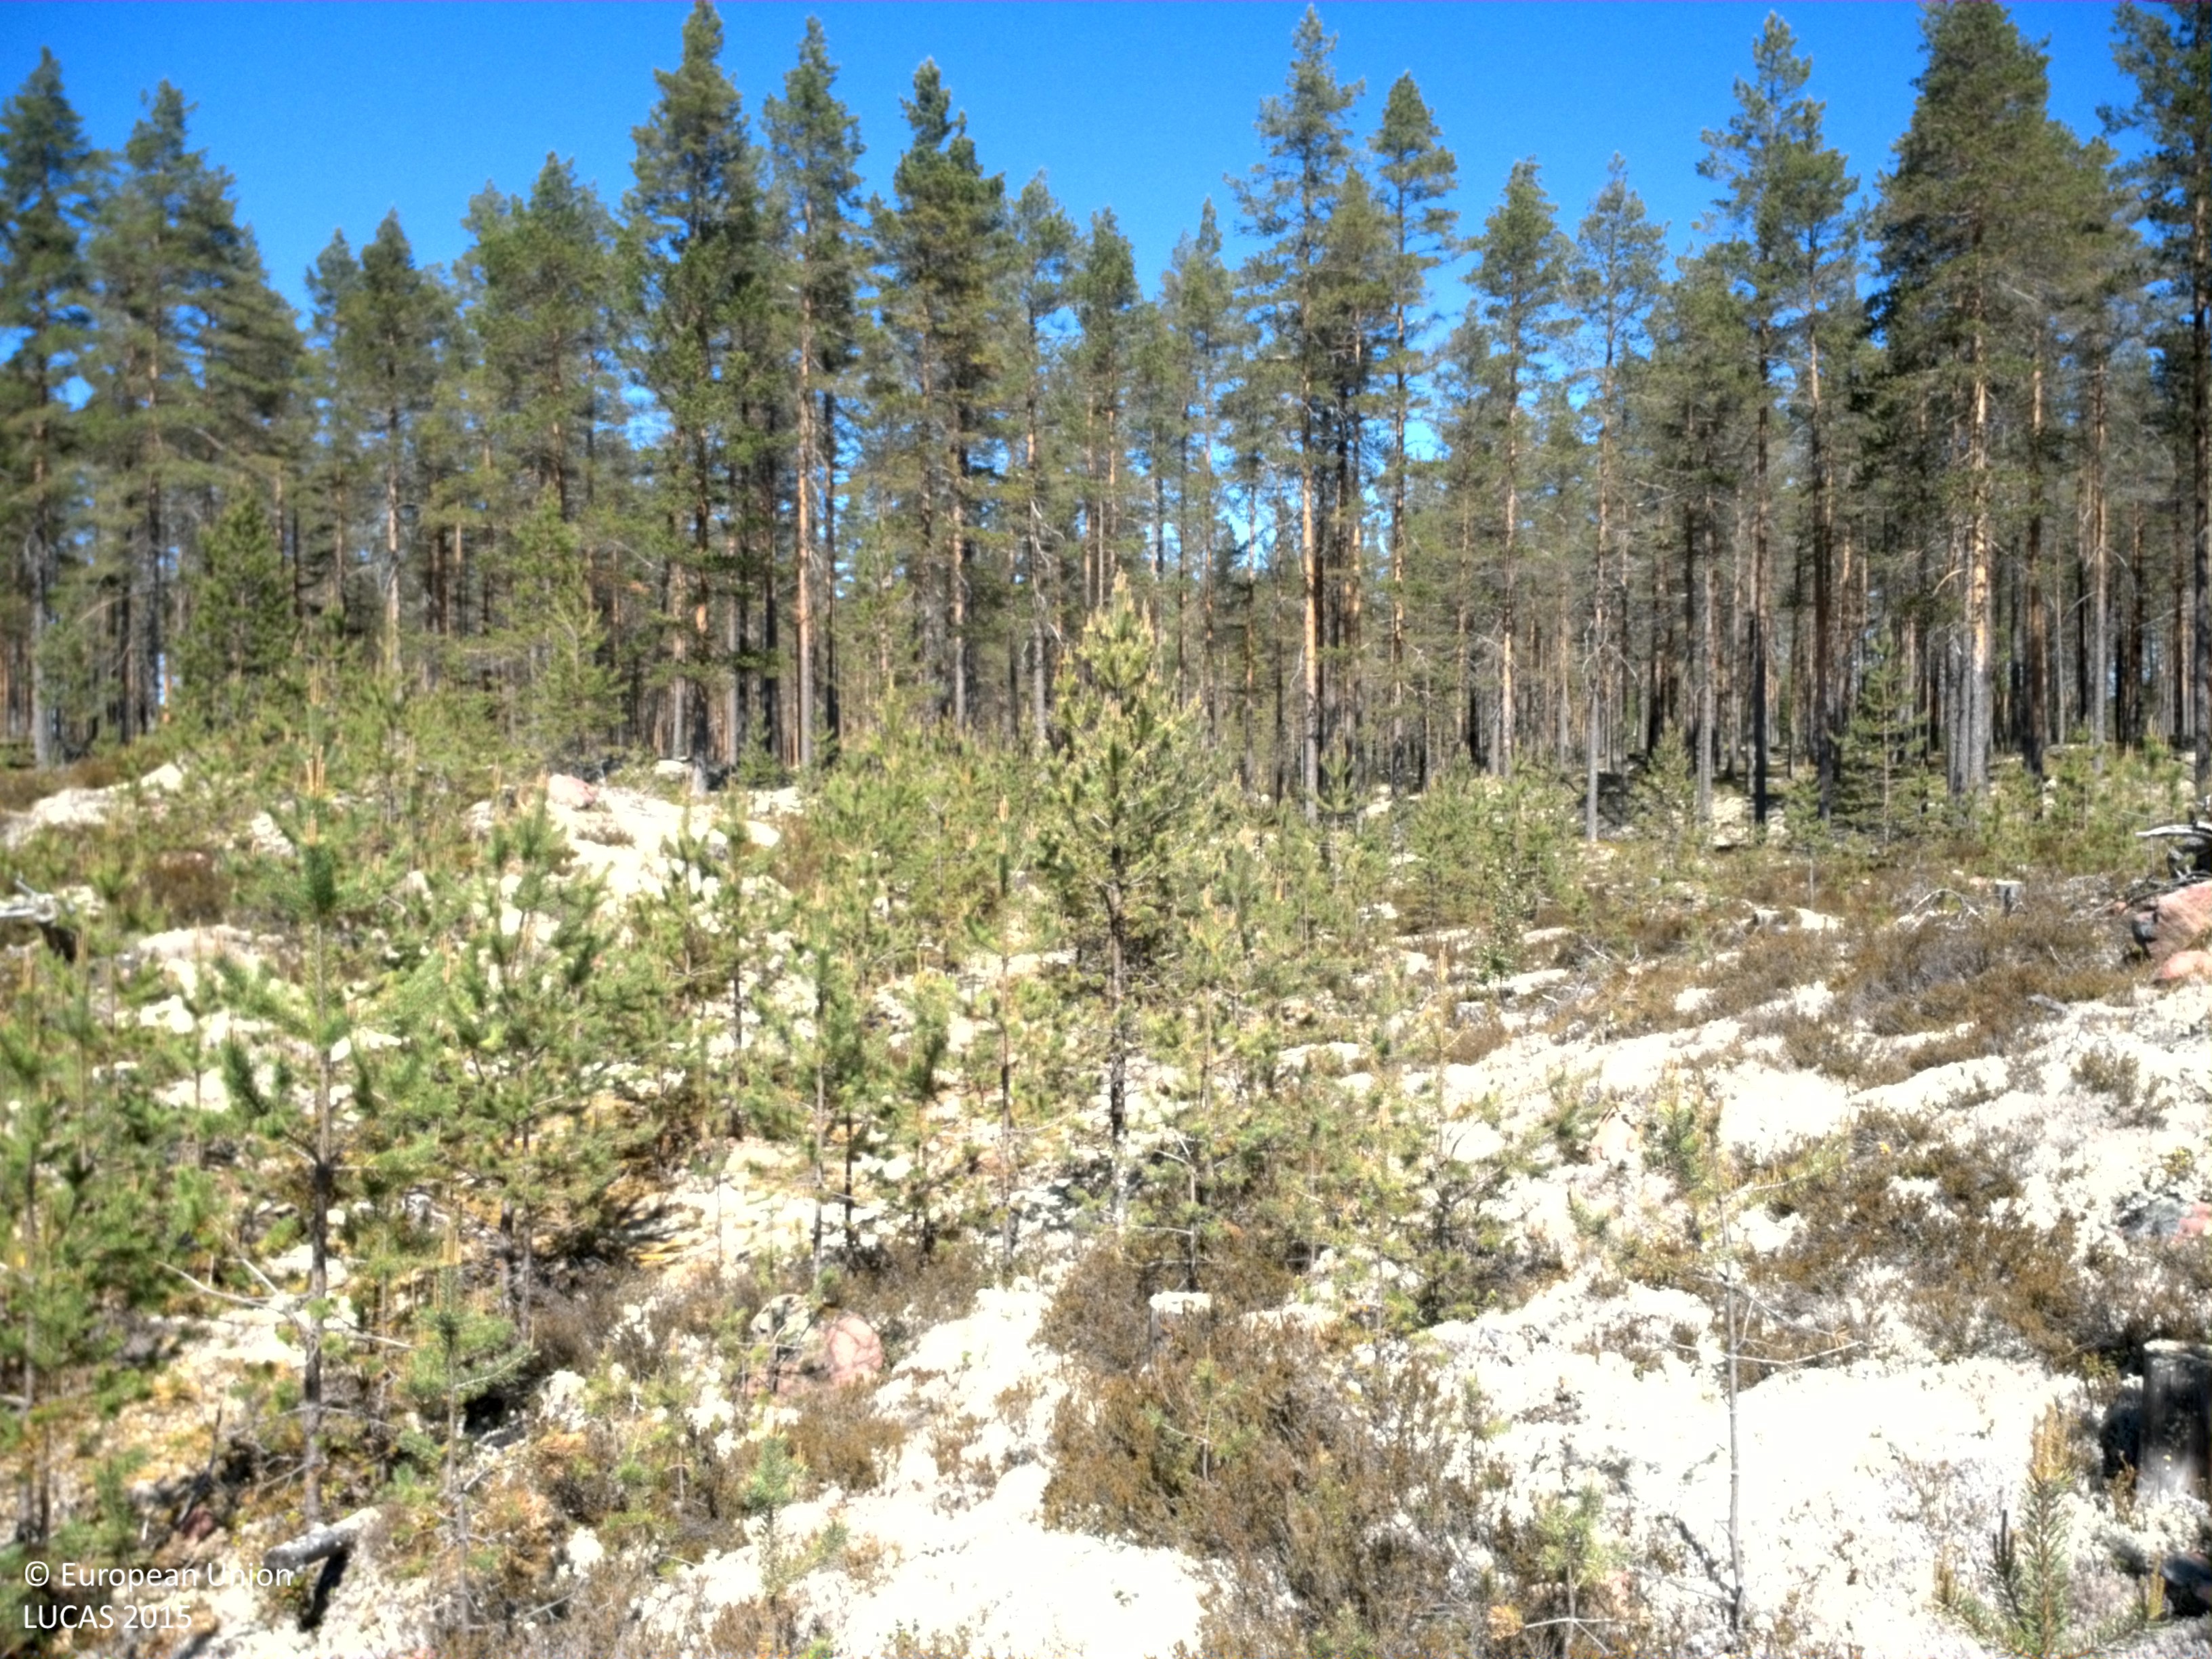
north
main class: Woodland
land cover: Pine dominated coniferous woodland
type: boreal forest
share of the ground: 25 - 50 %
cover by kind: coniferous forest trees 45 %, lichens and mosses 25 %, shrubs 15 %, consolidated bare surface 10 %, herbaceous plants 5 %
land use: Forestry
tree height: < 5 m
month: June
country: SE
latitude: 61.3597
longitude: 13.6343
